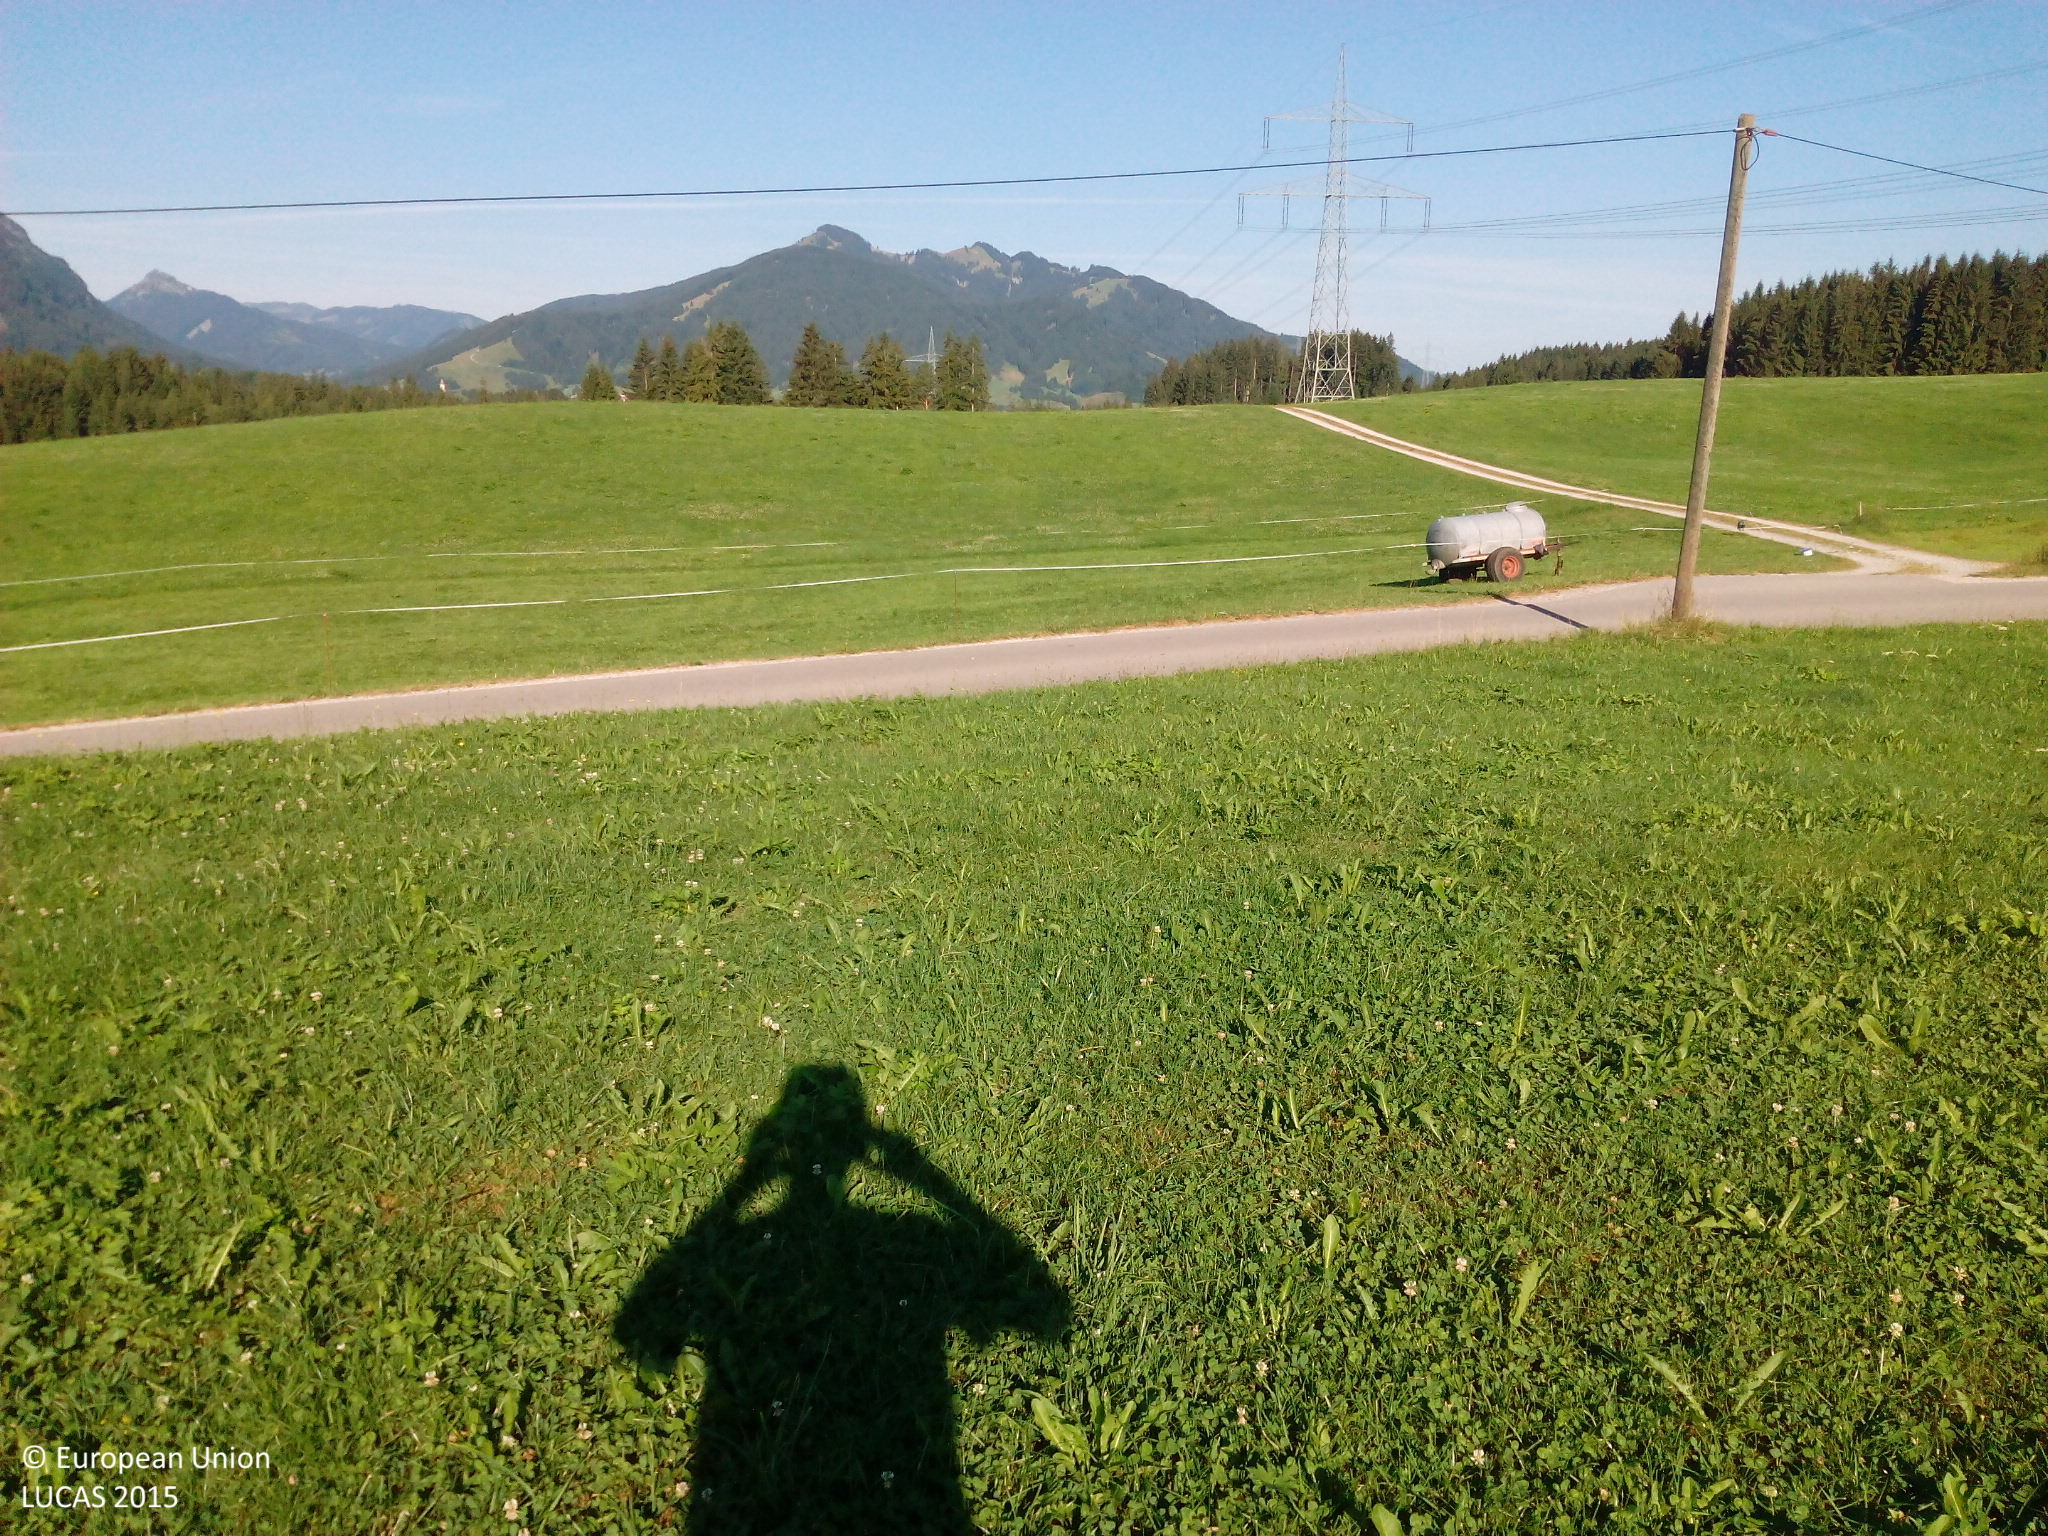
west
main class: Grassland
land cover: Grassland without tree/shrub cover
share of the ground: > 75 %
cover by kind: herbaceous plants 100 %
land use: Agriculture (excluding fallow land and kitchen gardens)
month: July
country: DE
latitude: 47.5920
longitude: 10.5979
